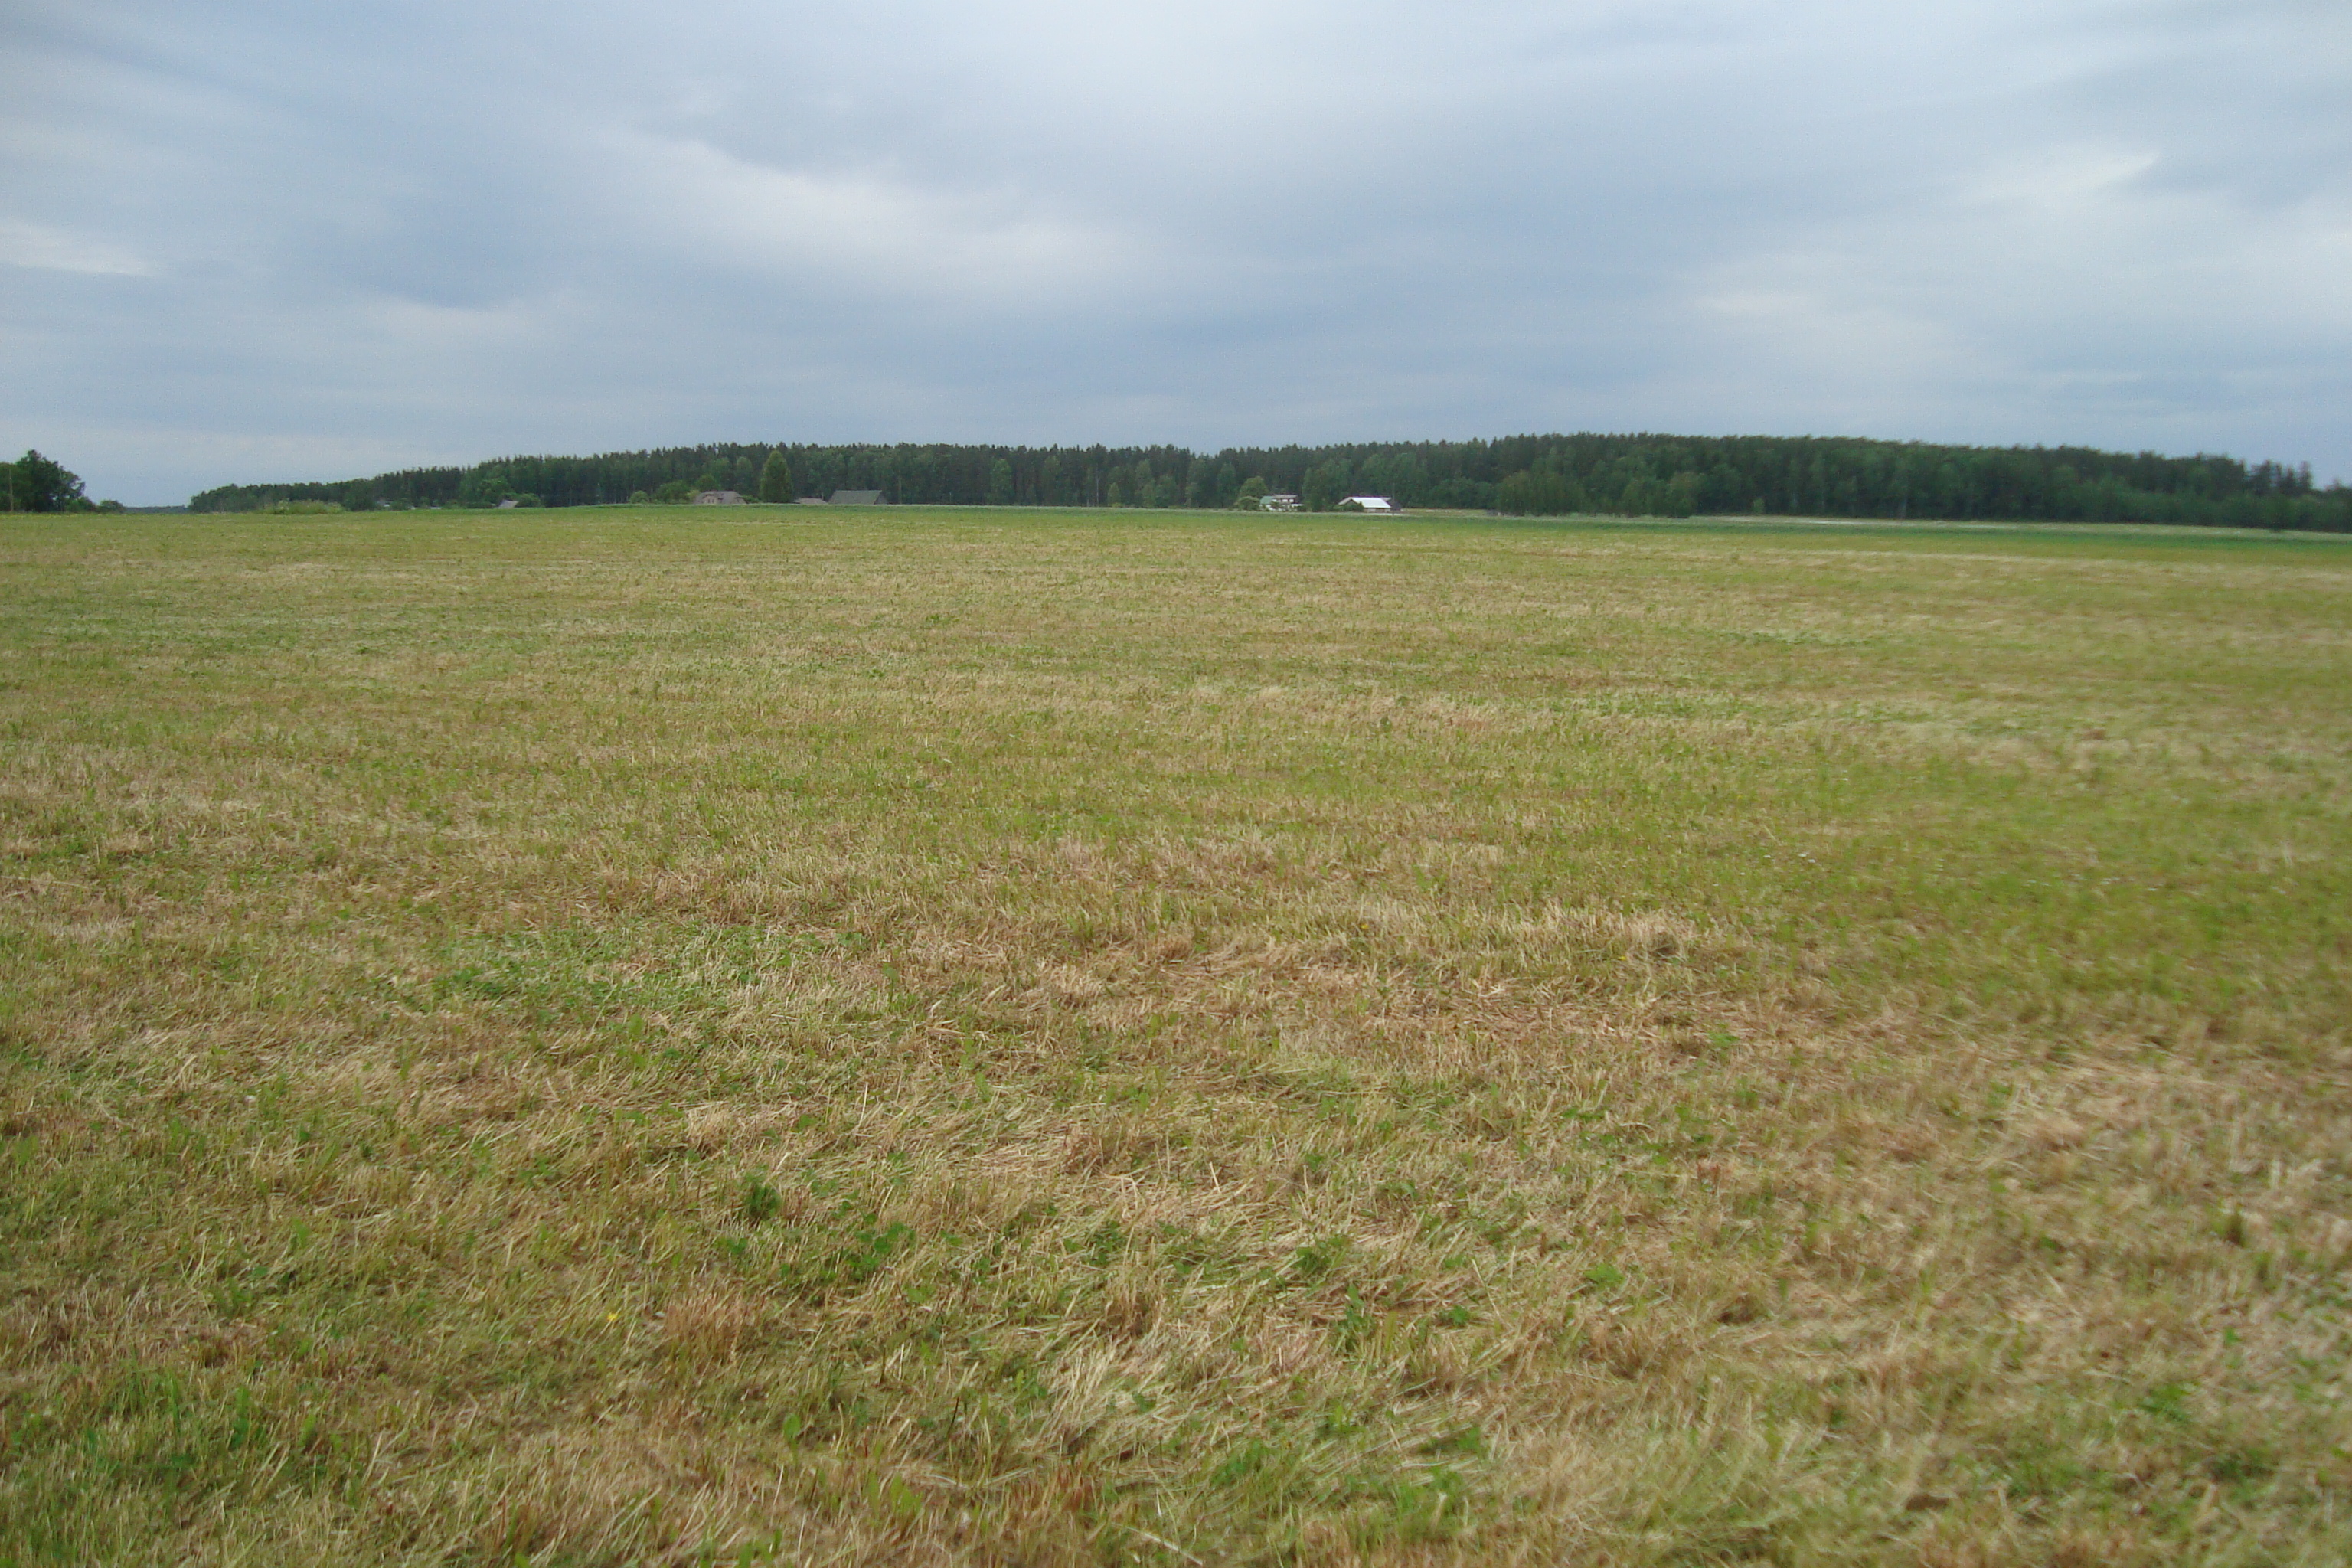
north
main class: Grassland
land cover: Grassland without tree/shrub cover
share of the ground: > 75 %
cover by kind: herbaceous plants 100 %
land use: Agriculture (excluding fallow land and kitchen gardens)
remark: Harvested field
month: June
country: LV
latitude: 57.2172
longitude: 26.4196
